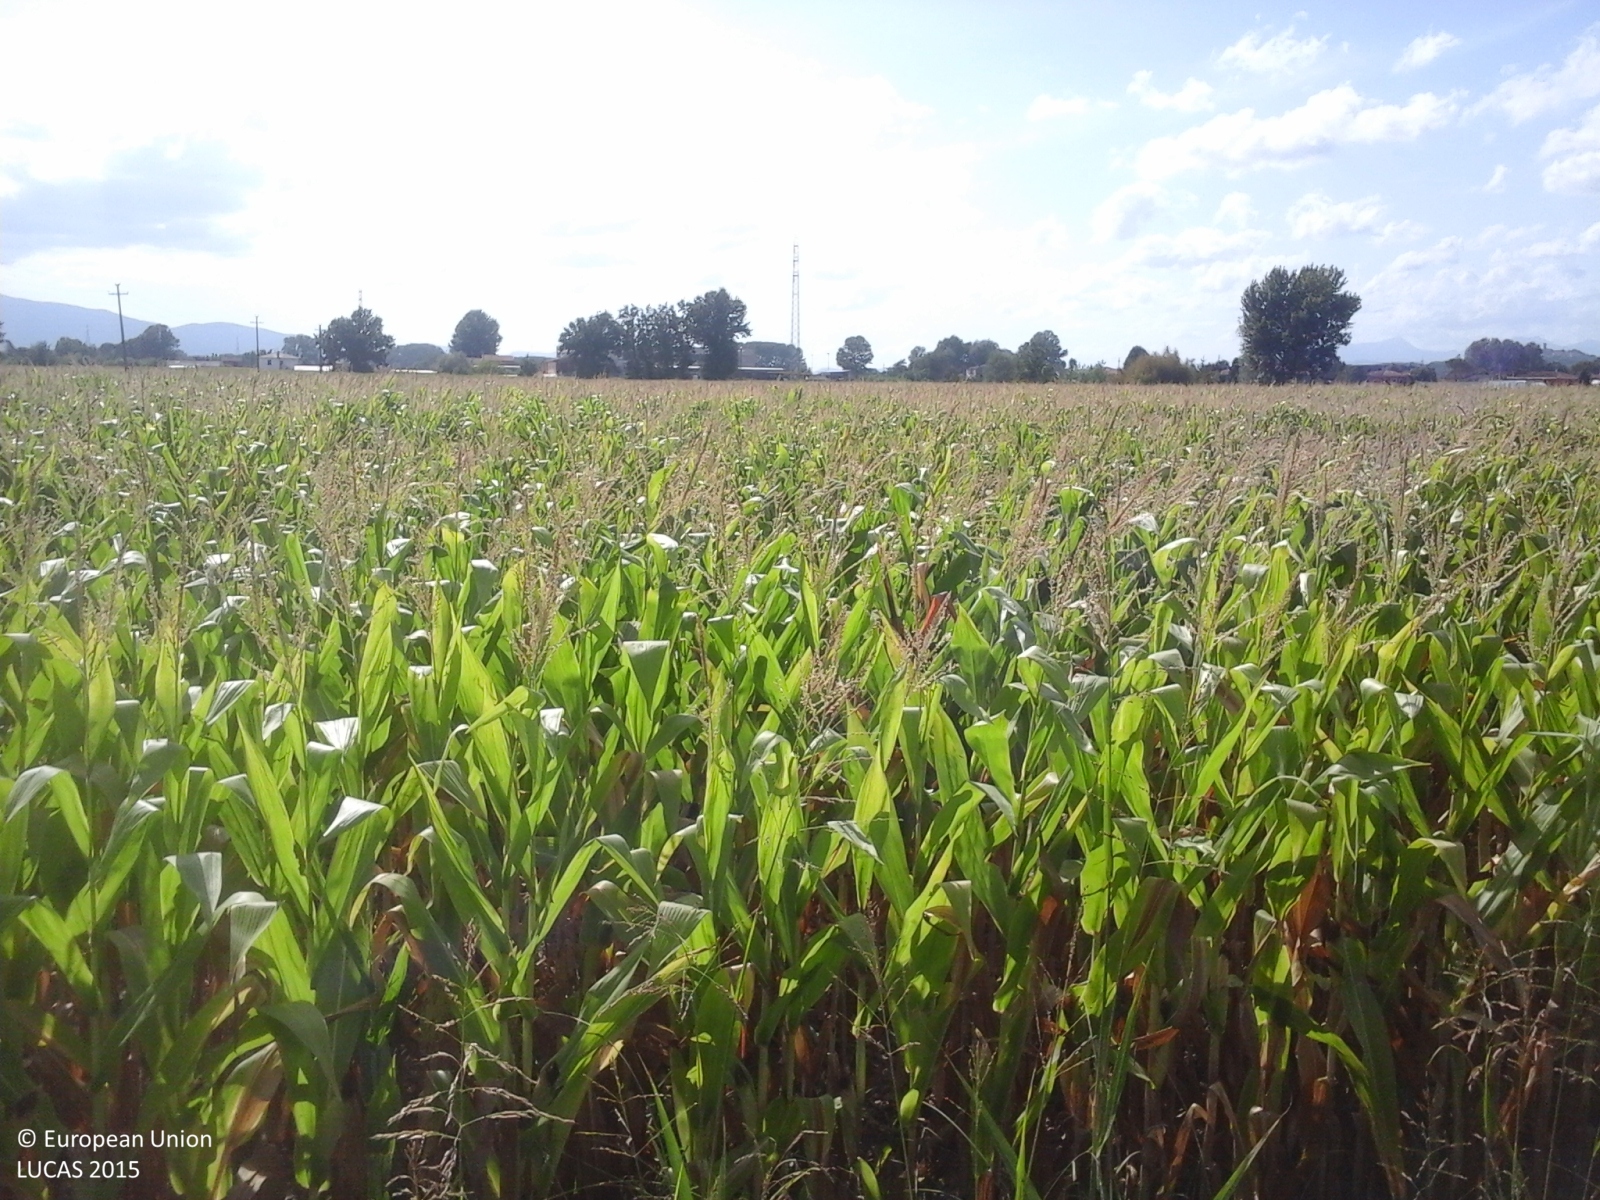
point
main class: Cropland
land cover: Maize
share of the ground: > 75 %
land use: Agriculture (excluding fallow land and kitchen gardens)
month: August
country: IT
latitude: 43.8248
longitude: 10.7317
